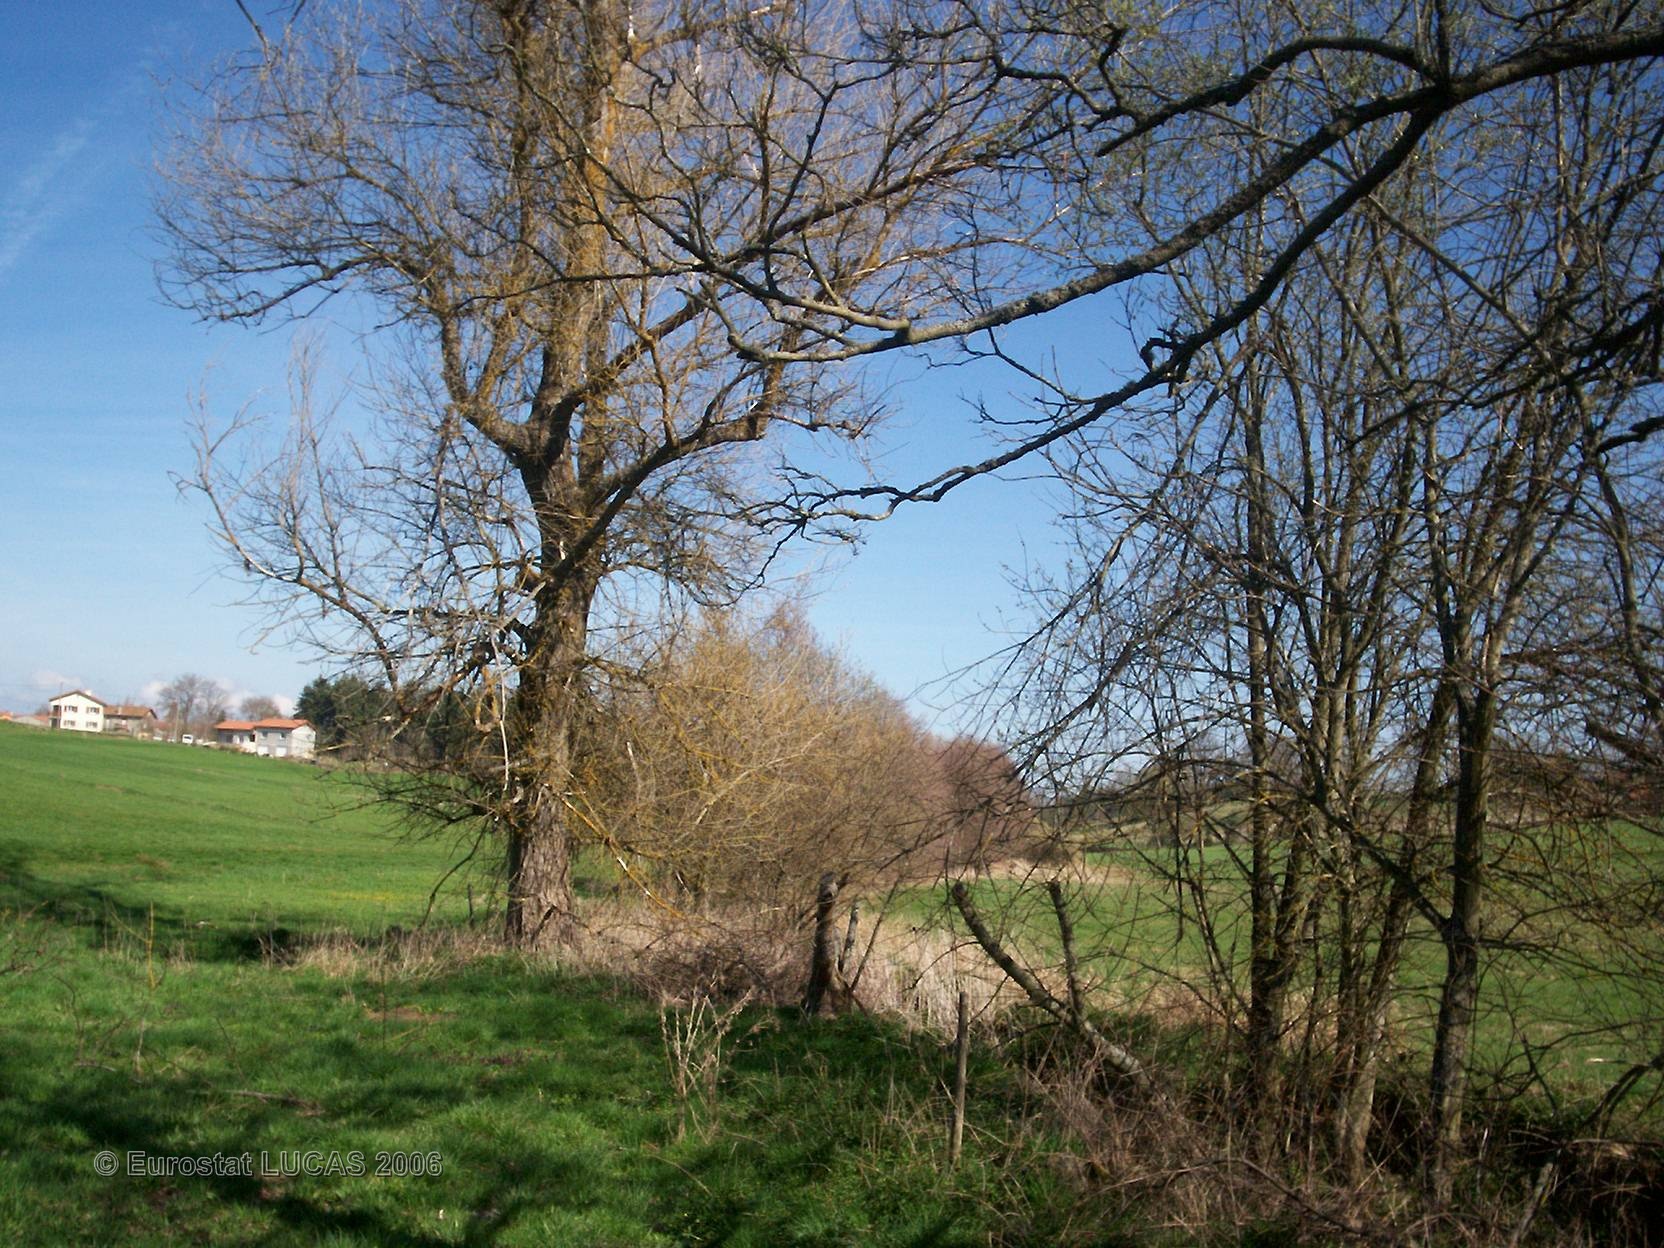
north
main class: Grassland
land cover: Grassland without tree/shrub cover
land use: Agriculture (excluding fallow land and kitchen gardens)
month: April
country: FR
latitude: 45.1817
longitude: 4.1884
